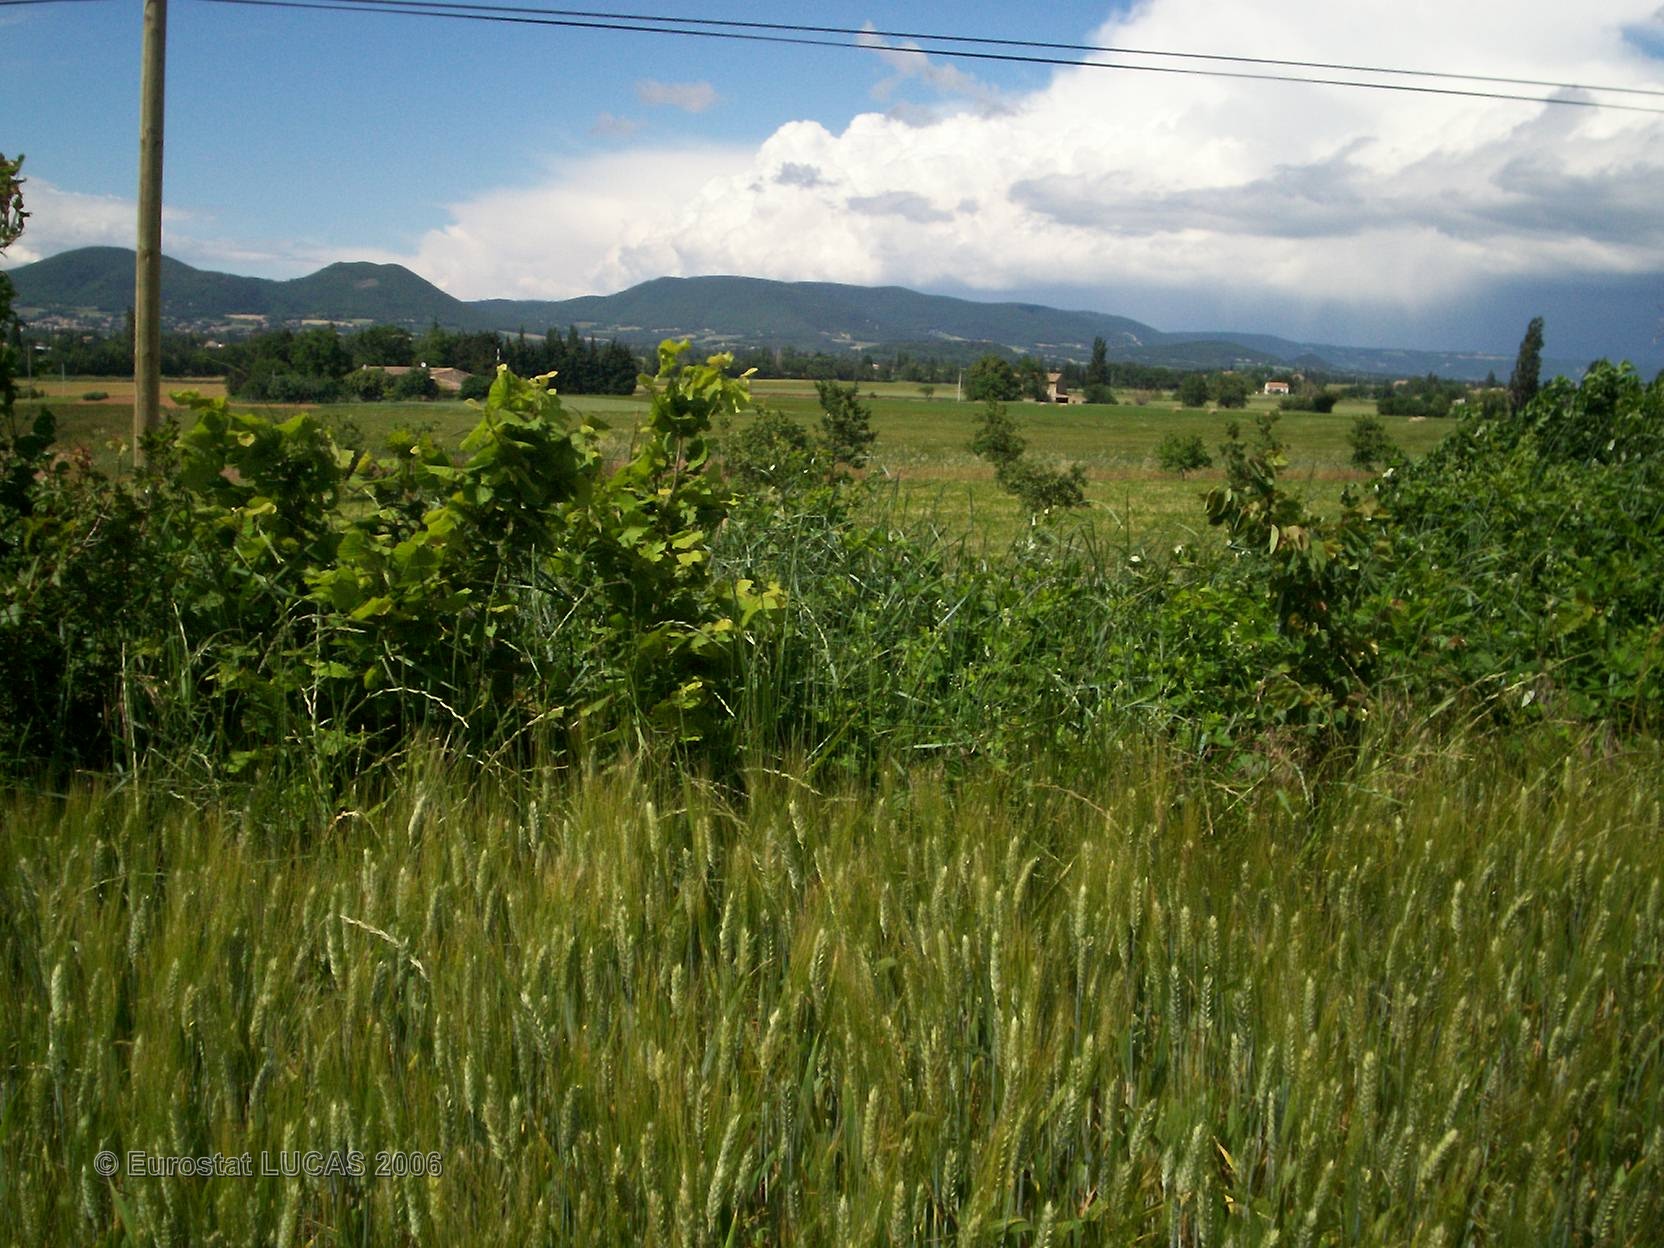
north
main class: Cropland
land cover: Durum wheat
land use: Agriculture (excluding fallow land and kitchen gardens)
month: May
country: FR
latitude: 44.5651
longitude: 4.8318
